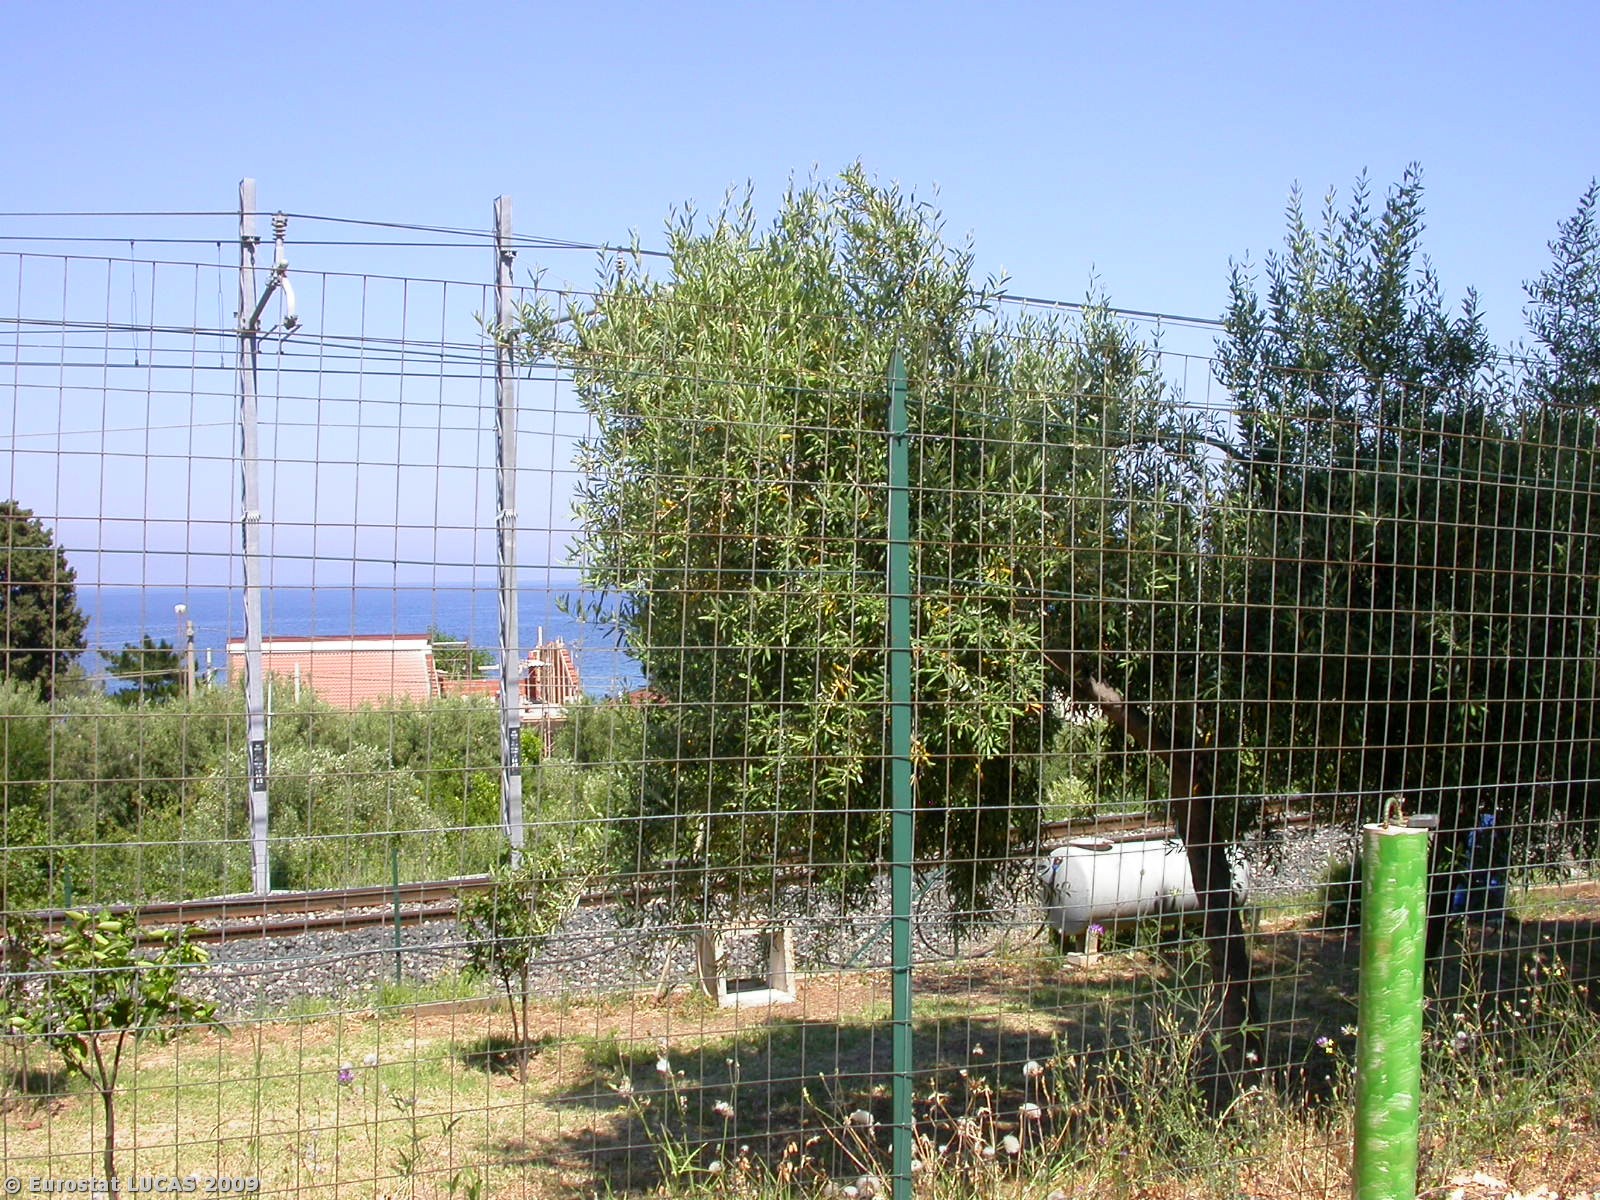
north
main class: Cropland
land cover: Olive groves
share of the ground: 50 - 75 %
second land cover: Spontaneously vegetated surfaces
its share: 25 - 50 %
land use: Agriculture (excluding fallow land and kitchen gardens)
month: June
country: IT
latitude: 38.1636
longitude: 14.9554
